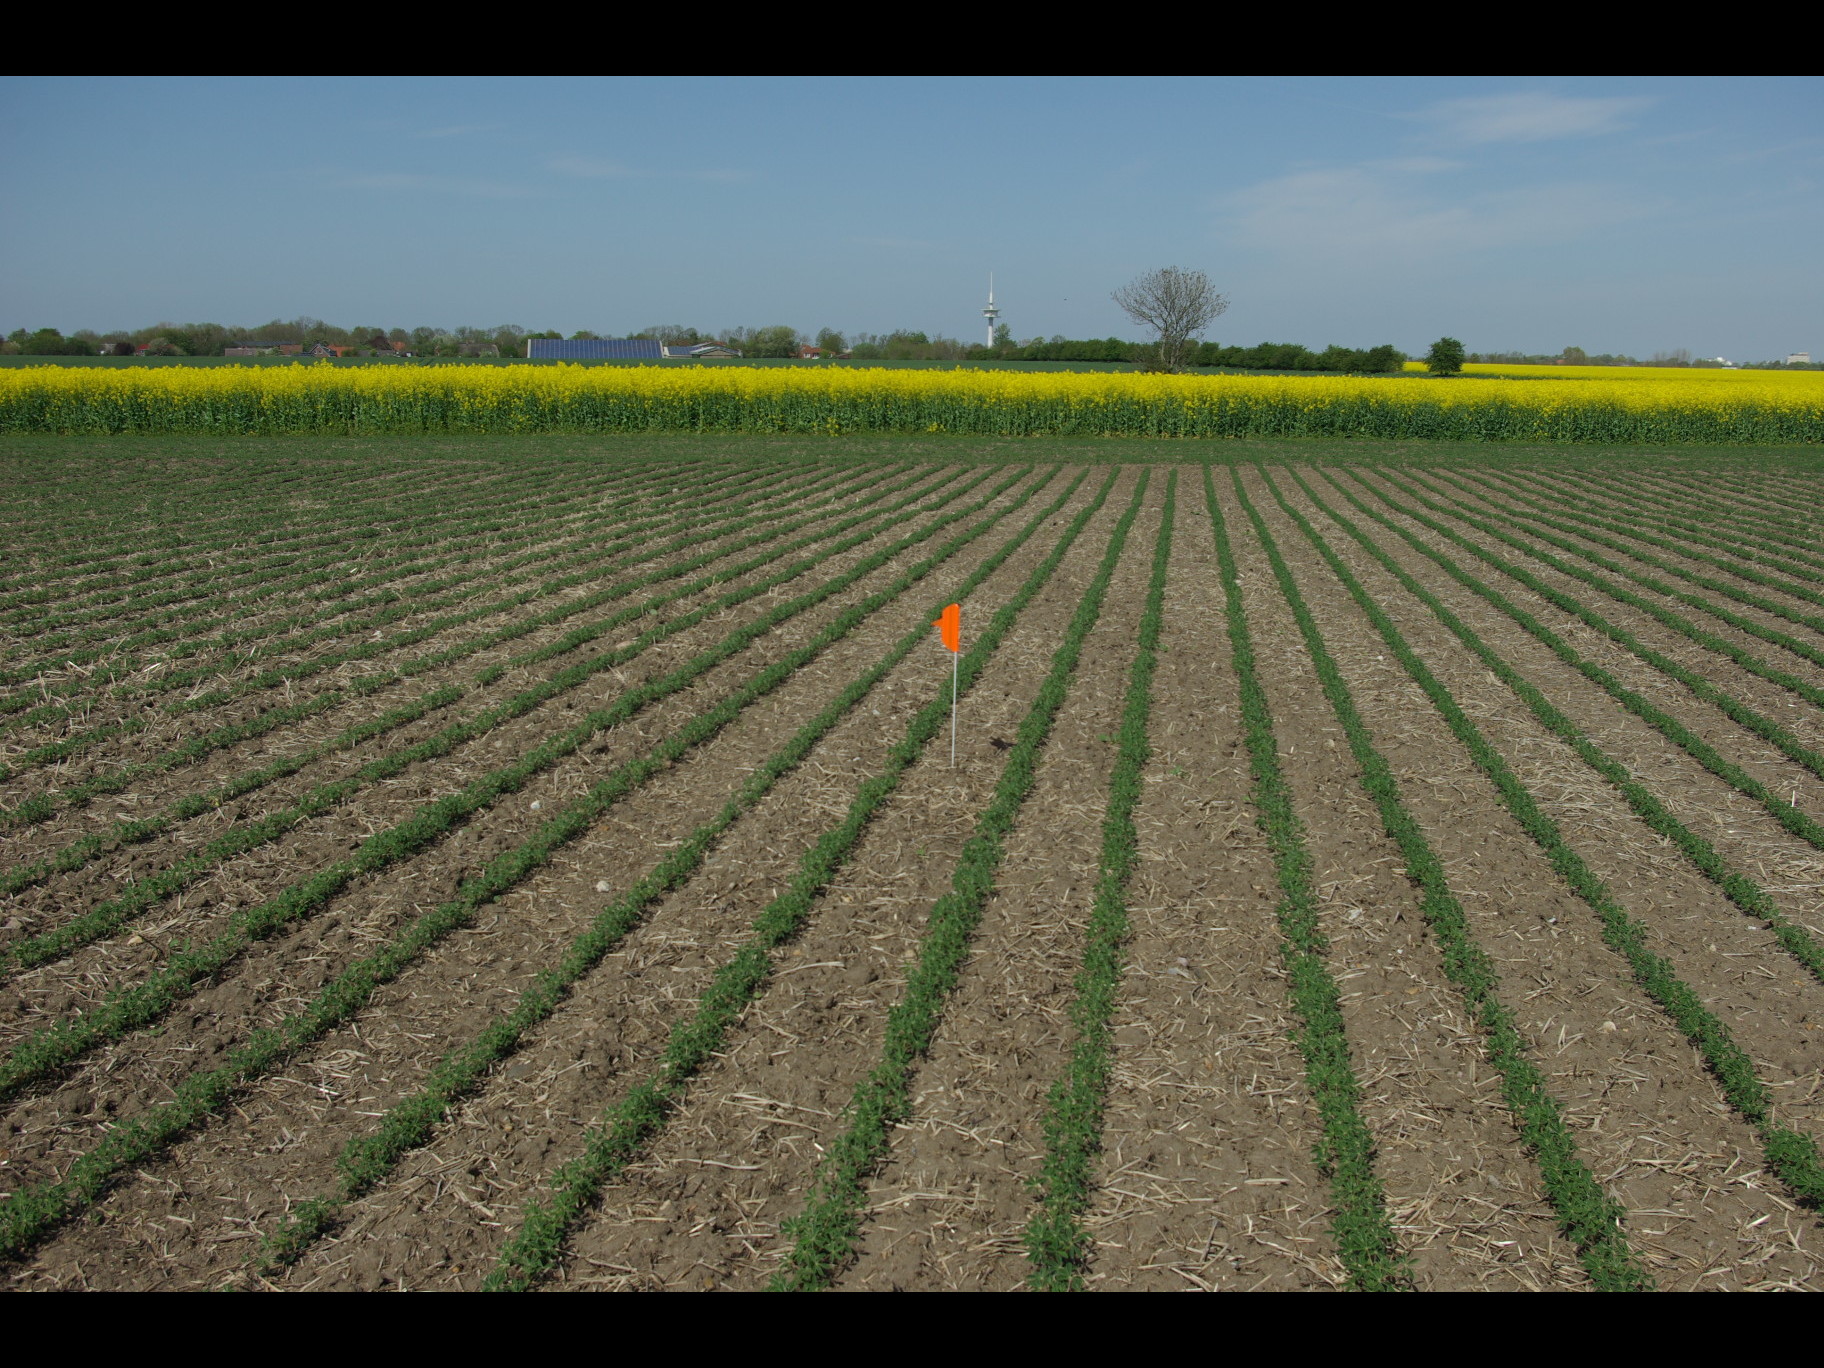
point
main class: Cropland
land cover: Dry pulses
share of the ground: 10 - 25 %
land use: Agriculture (excluding fallow land and kitchen gardens)
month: May
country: DE
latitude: 54.4746
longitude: 11.1875
